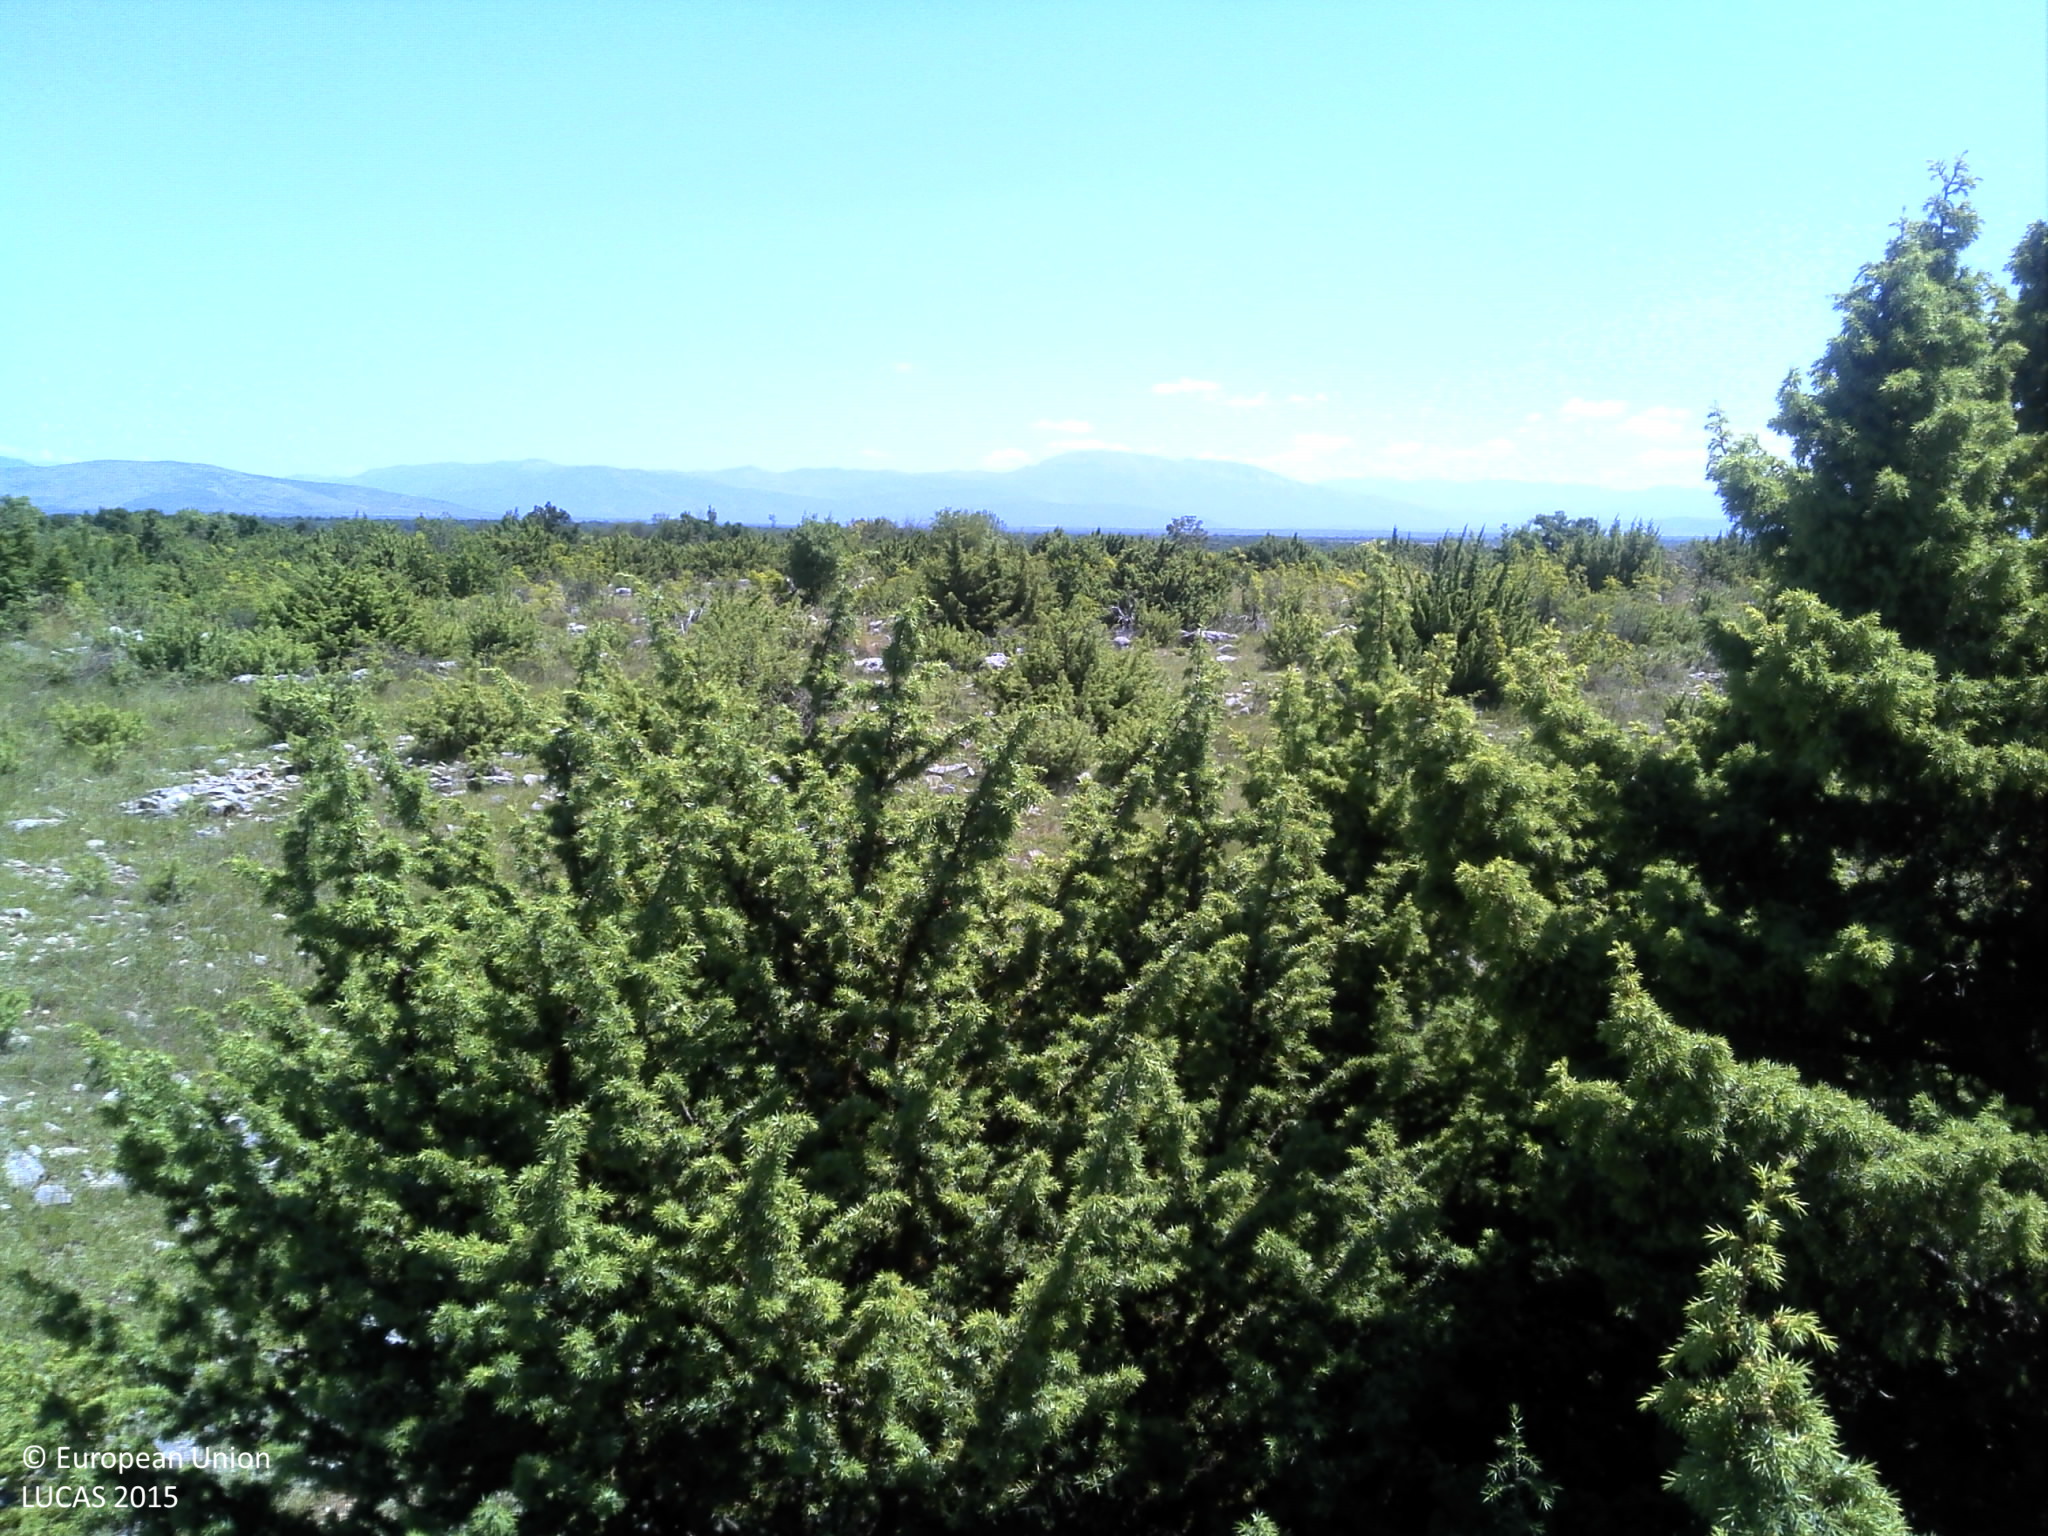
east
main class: Shrubland
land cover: Shrubland with sparse tree cover
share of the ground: 10 - 25 %
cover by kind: unconsolidated bare surface 35 %, herbaceous plants 30 %, shrubs 20 %, consolidated bare surface 10 %, coniferous forest trees 5 %
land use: Semi-natural and natural areas not in use
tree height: < 5 m
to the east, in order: Shrubland with sparse tree cover; Tracks; Shrubland with sparse tree cover; Dry stone walls; Grassland with sparse tree/shrub cover; Dry stone walls; Grassland with sparse tree/shrub cover
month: June
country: HR
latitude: 44.0146
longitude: 15.9921
